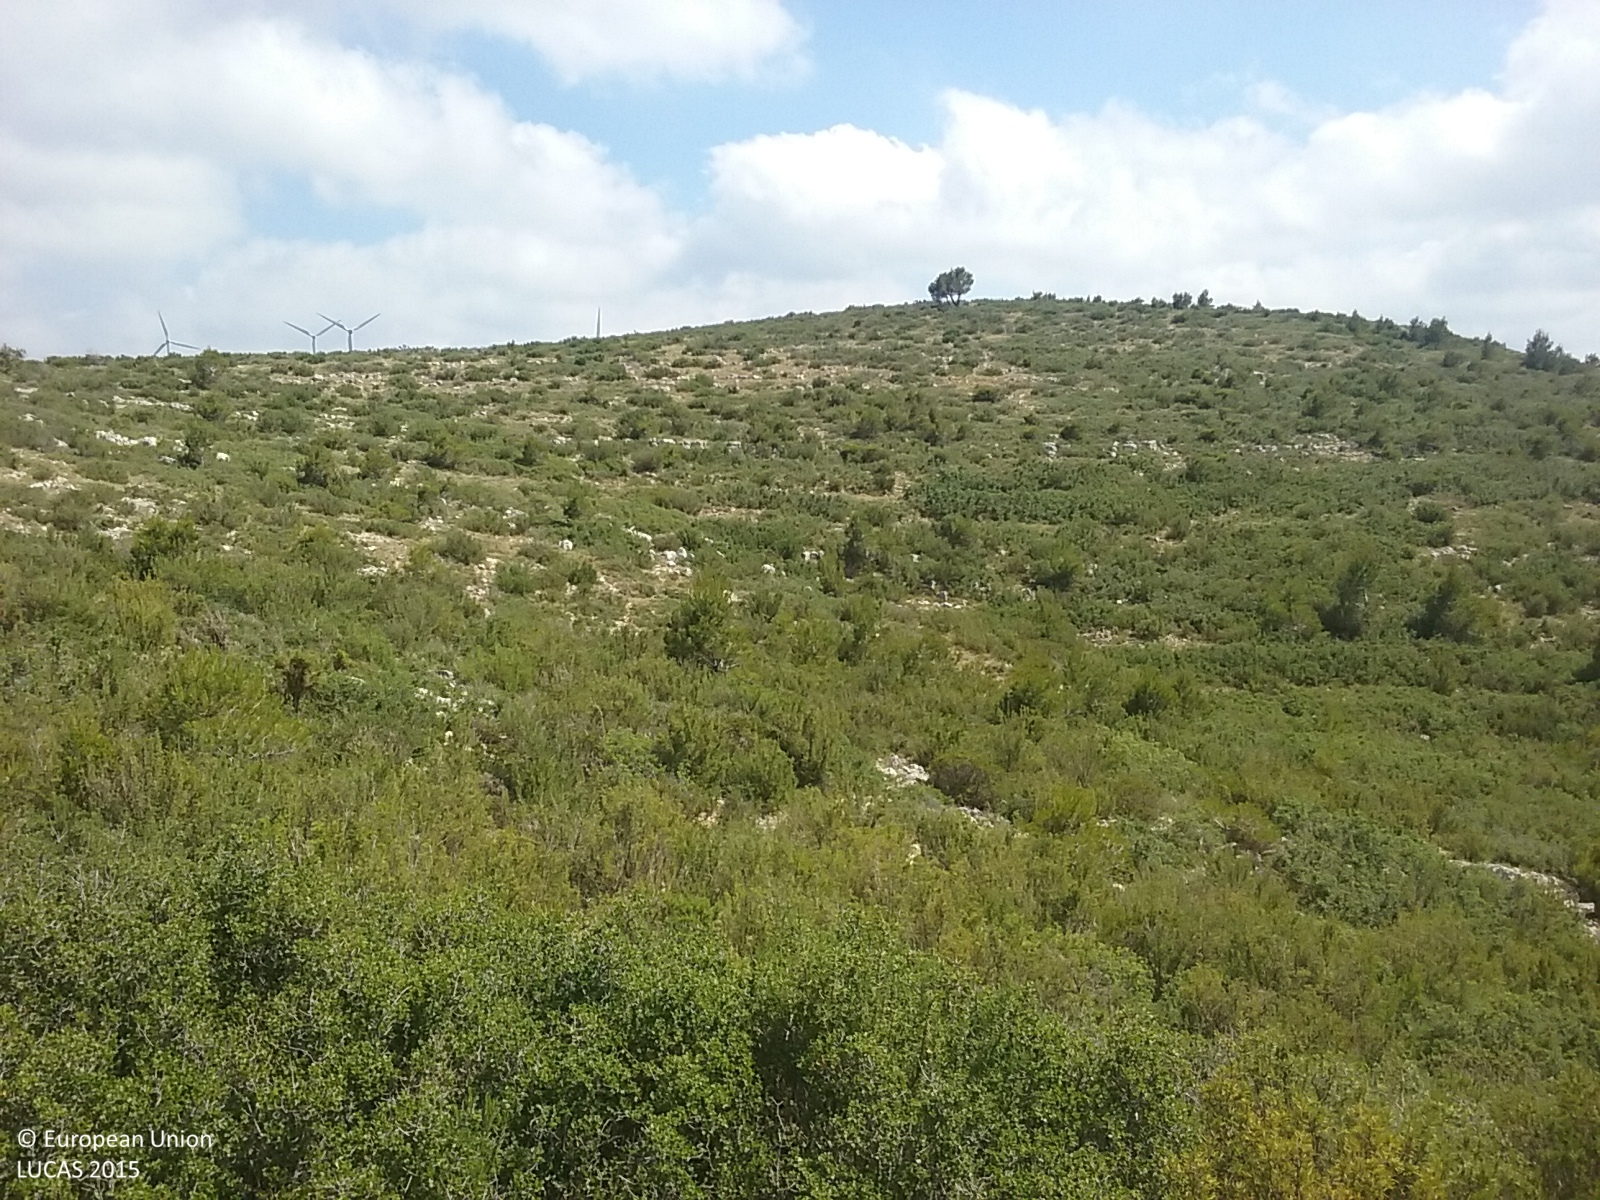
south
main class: Shrubland
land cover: Shrubland with sparse tree cover
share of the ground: > 75 %
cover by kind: shrubs 80 %, herbaceous plants 10 %, coniferous forest trees 5 %, unconsolidated bare surface 5 %
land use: Semi-natural and natural areas not in use
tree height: < 5 m
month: June
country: ES
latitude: 40.8938
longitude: 0.6524
